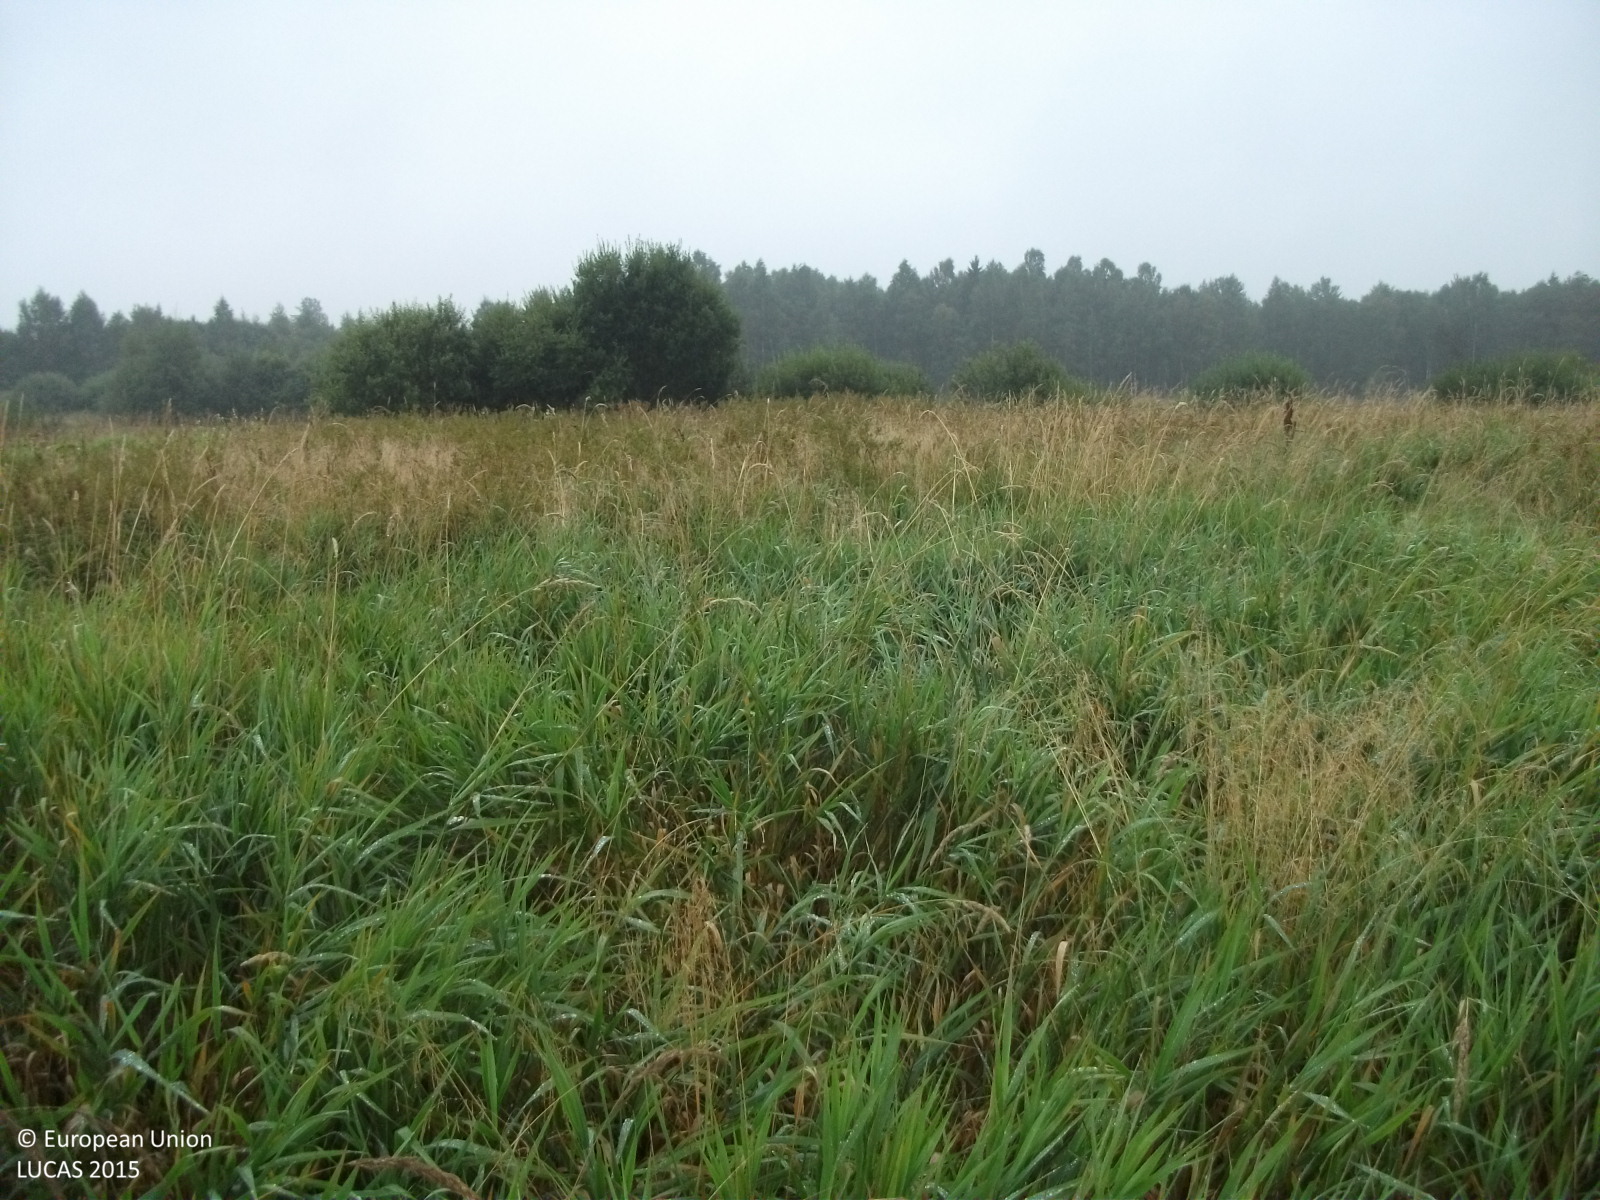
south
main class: Grassland
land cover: Grassland without tree/shrub cover
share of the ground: > 75 %
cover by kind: herbaceous plants 100 %
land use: Agriculture (excluding fallow land and kitchen gardens)
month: September
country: LV
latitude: 57.5042
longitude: 24.6302
